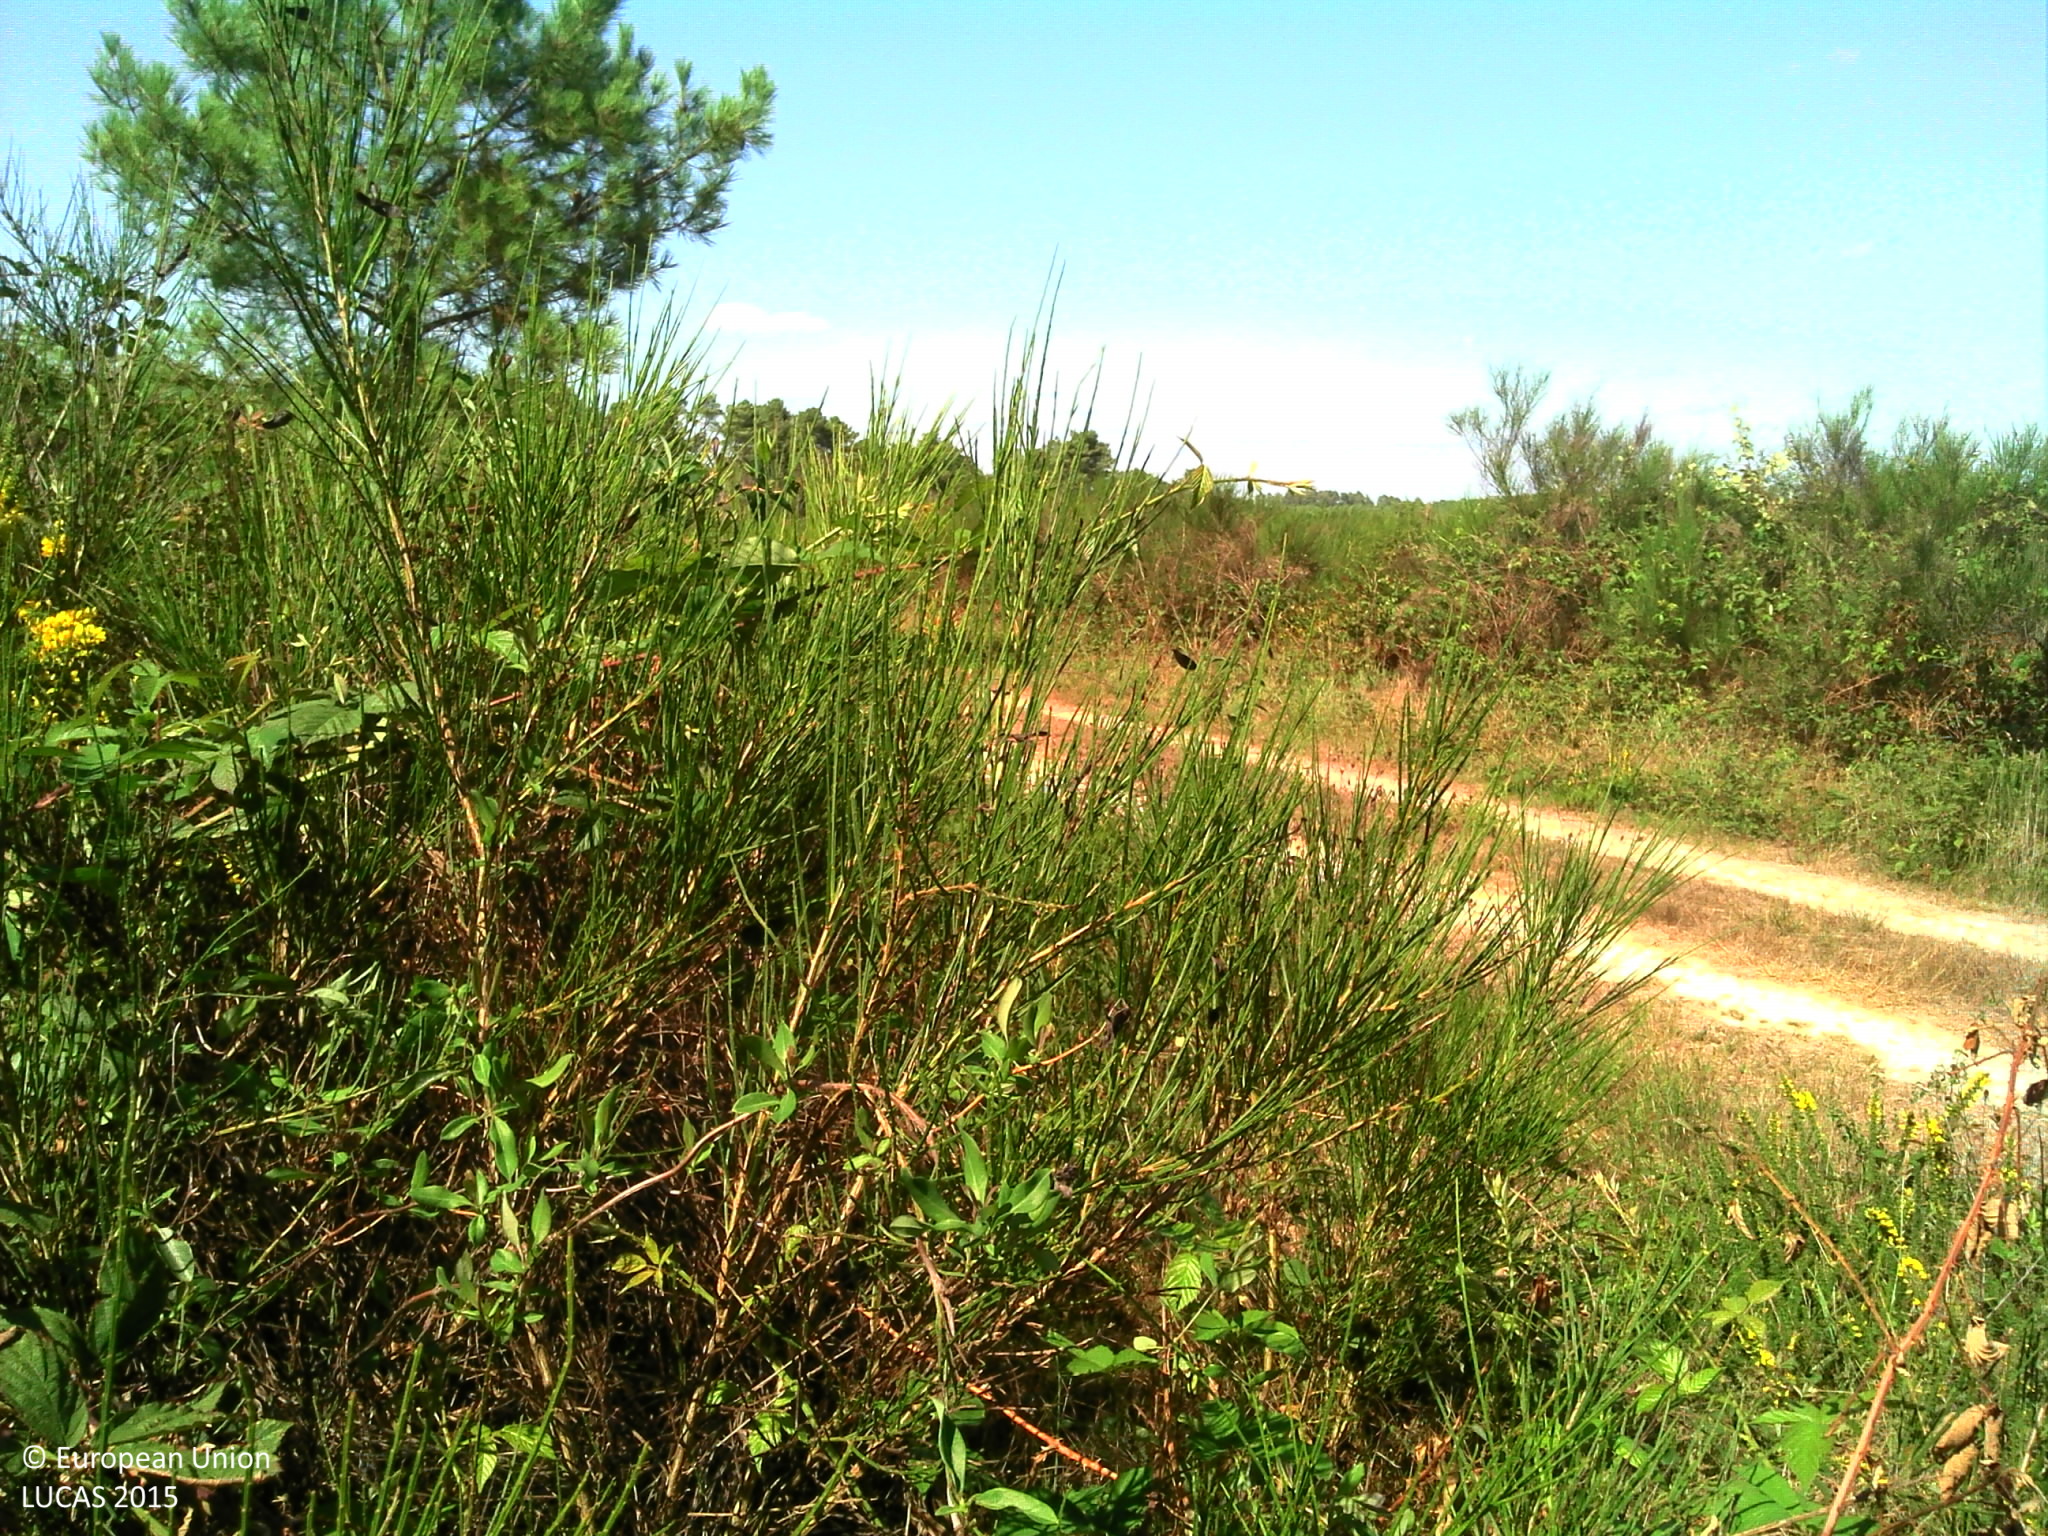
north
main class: Woodland
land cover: Pine dominated coniferous woodland
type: exotic forest
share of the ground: > 75 %
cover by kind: coniferous forest trees 70 %, shrubs 20 %, herbaceous plants 10 %
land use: Forestry
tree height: < 5 m
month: August
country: FR
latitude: 44.9813
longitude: 0.4654
